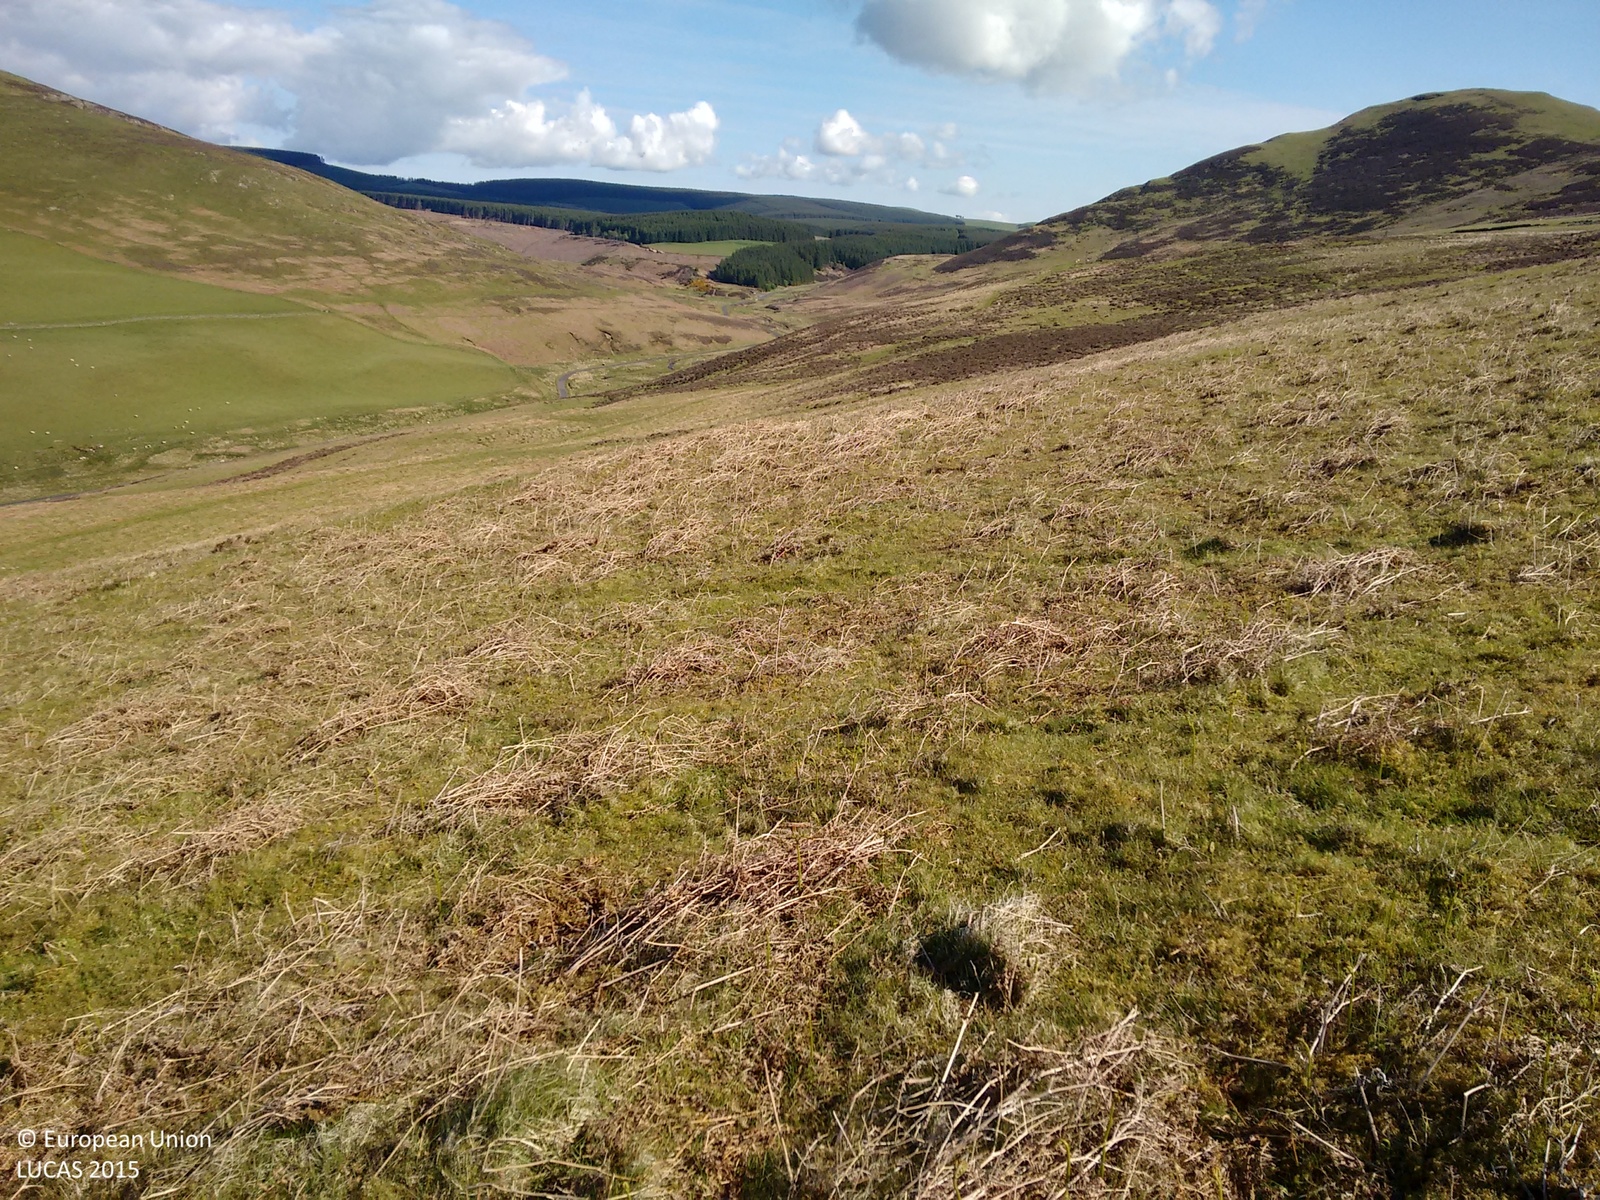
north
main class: Grassland
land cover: Grassland without tree/shrub cover
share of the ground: > 75 %
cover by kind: herbaceous plants 90 %, lichens and mosses 10 %
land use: Agriculture (excluding fallow land and kitchen gardens)
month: June
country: GB
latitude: 55.6607
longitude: -3.2511
